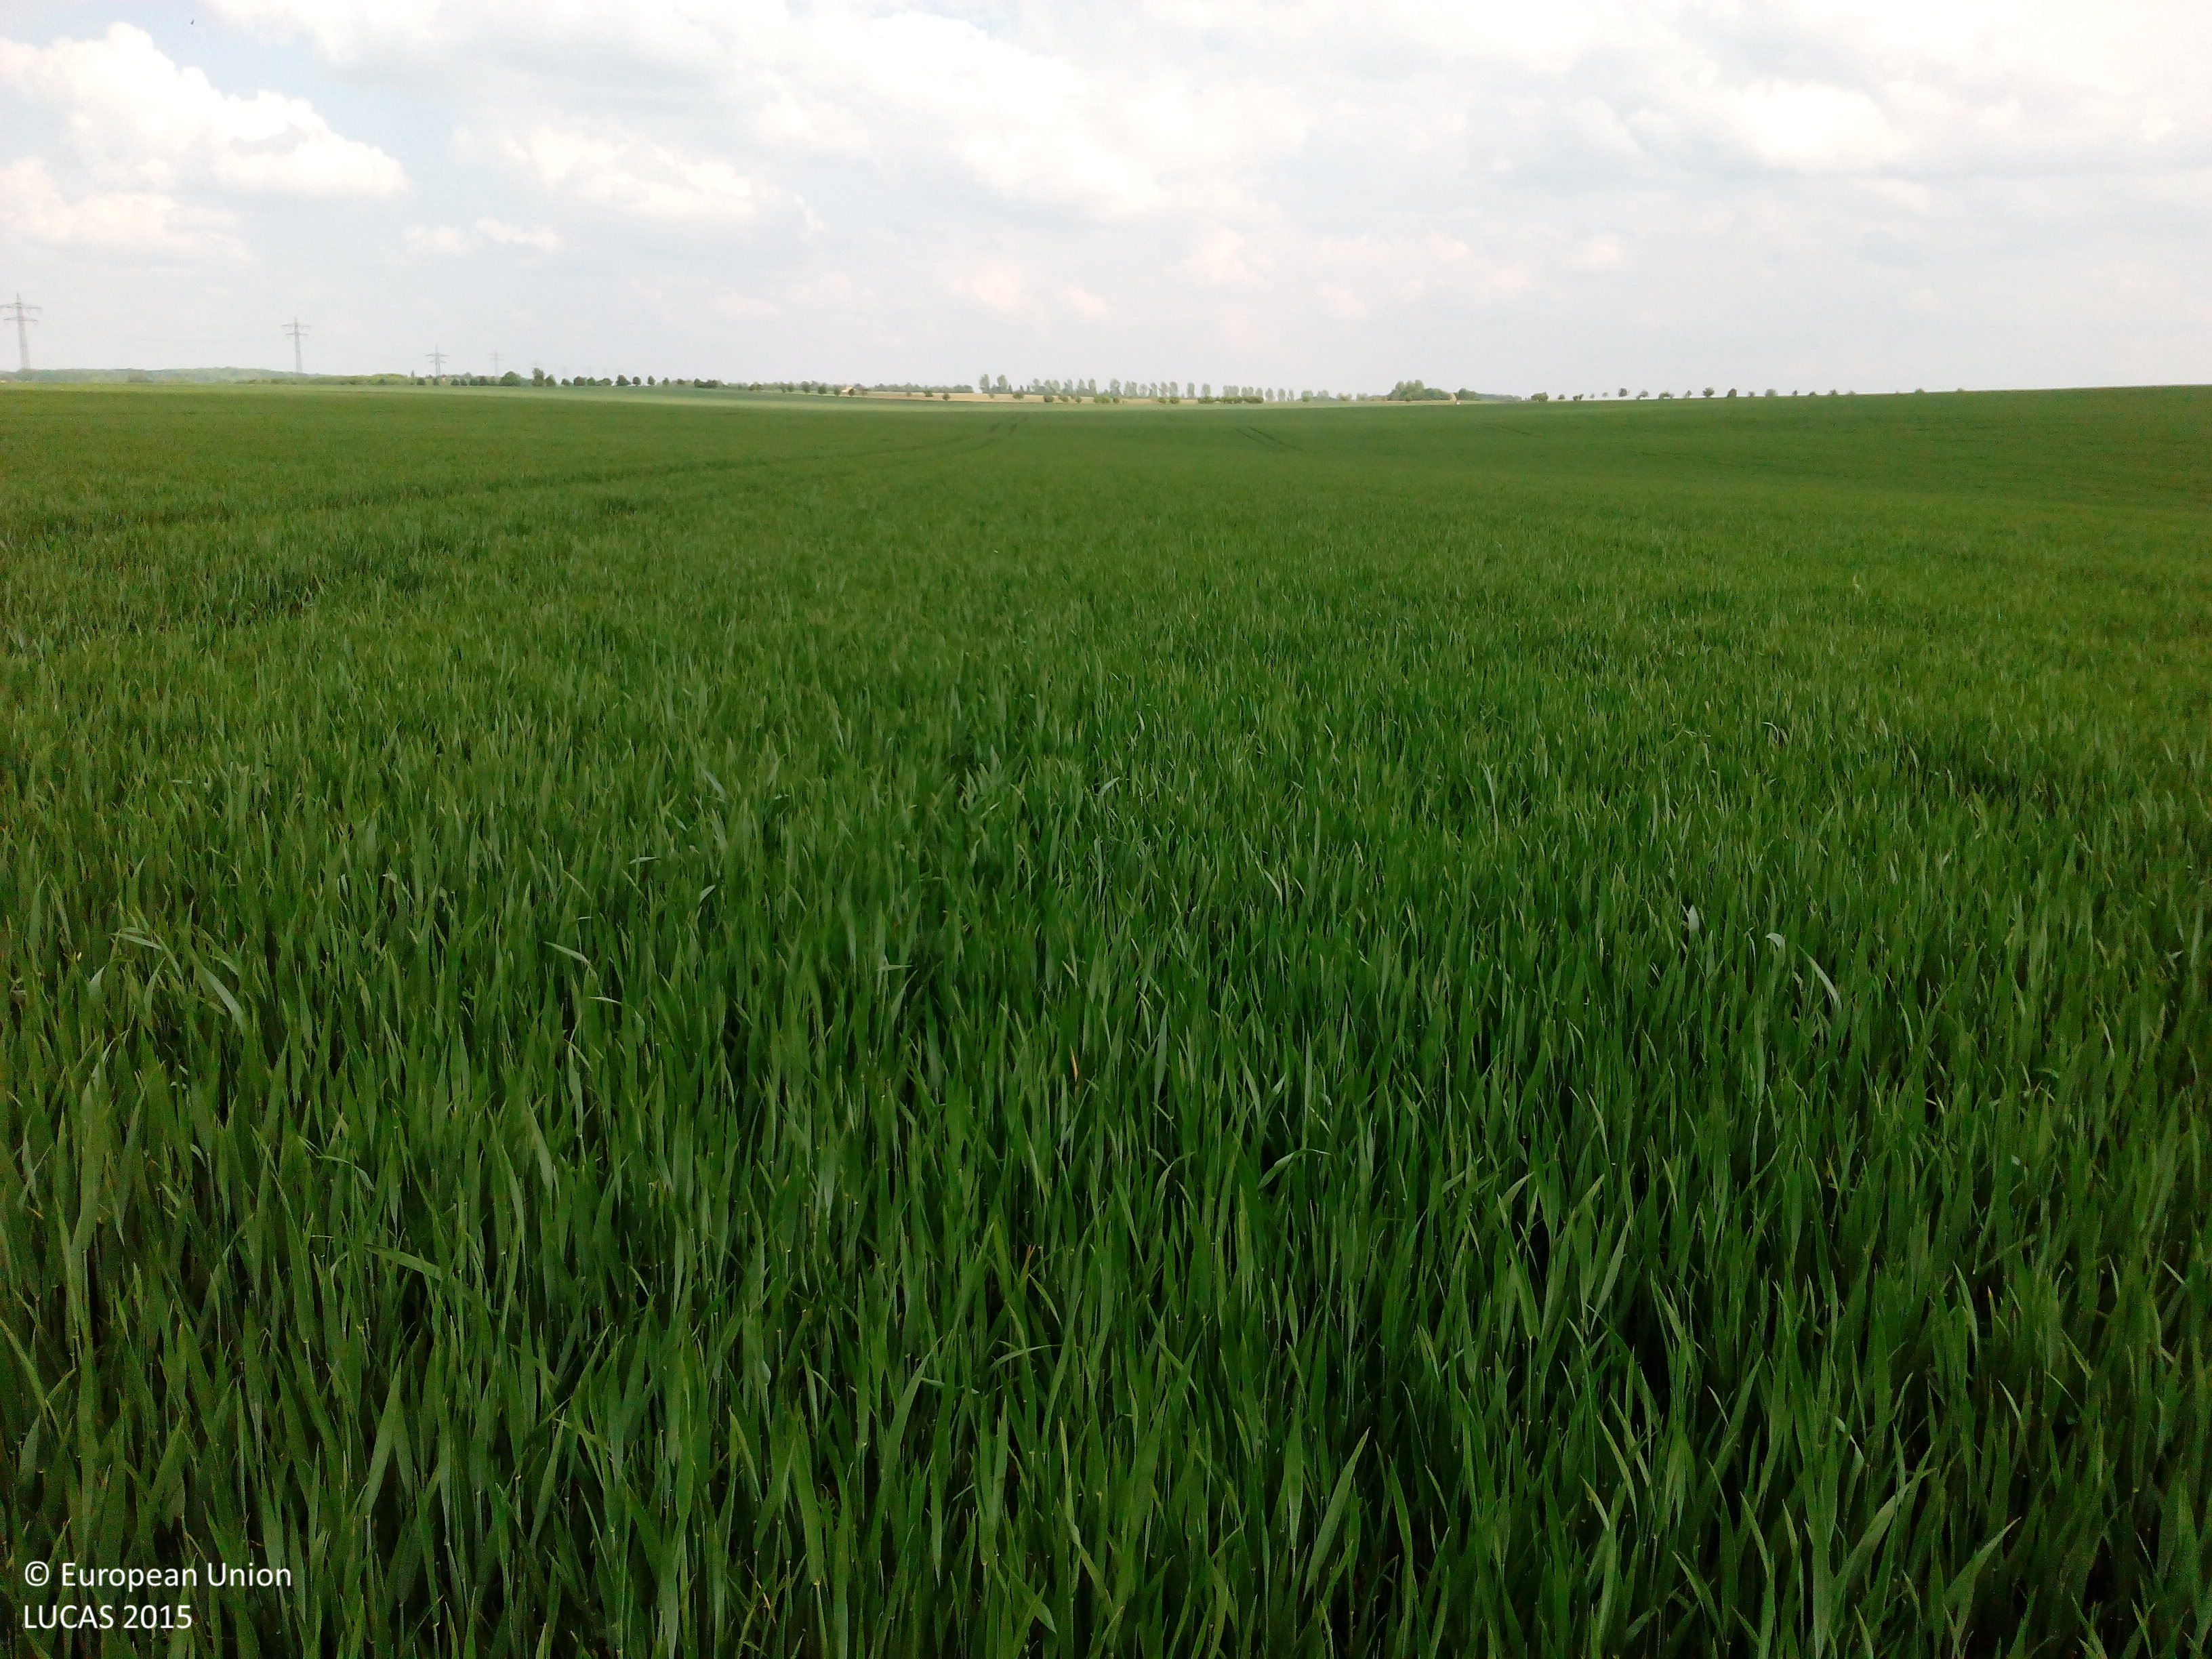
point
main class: Cropland
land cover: Common wheat
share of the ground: > 75 %
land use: Agriculture (excluding fallow land and kitchen gardens)
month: May
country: DE
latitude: 50.9481
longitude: 11.4657
